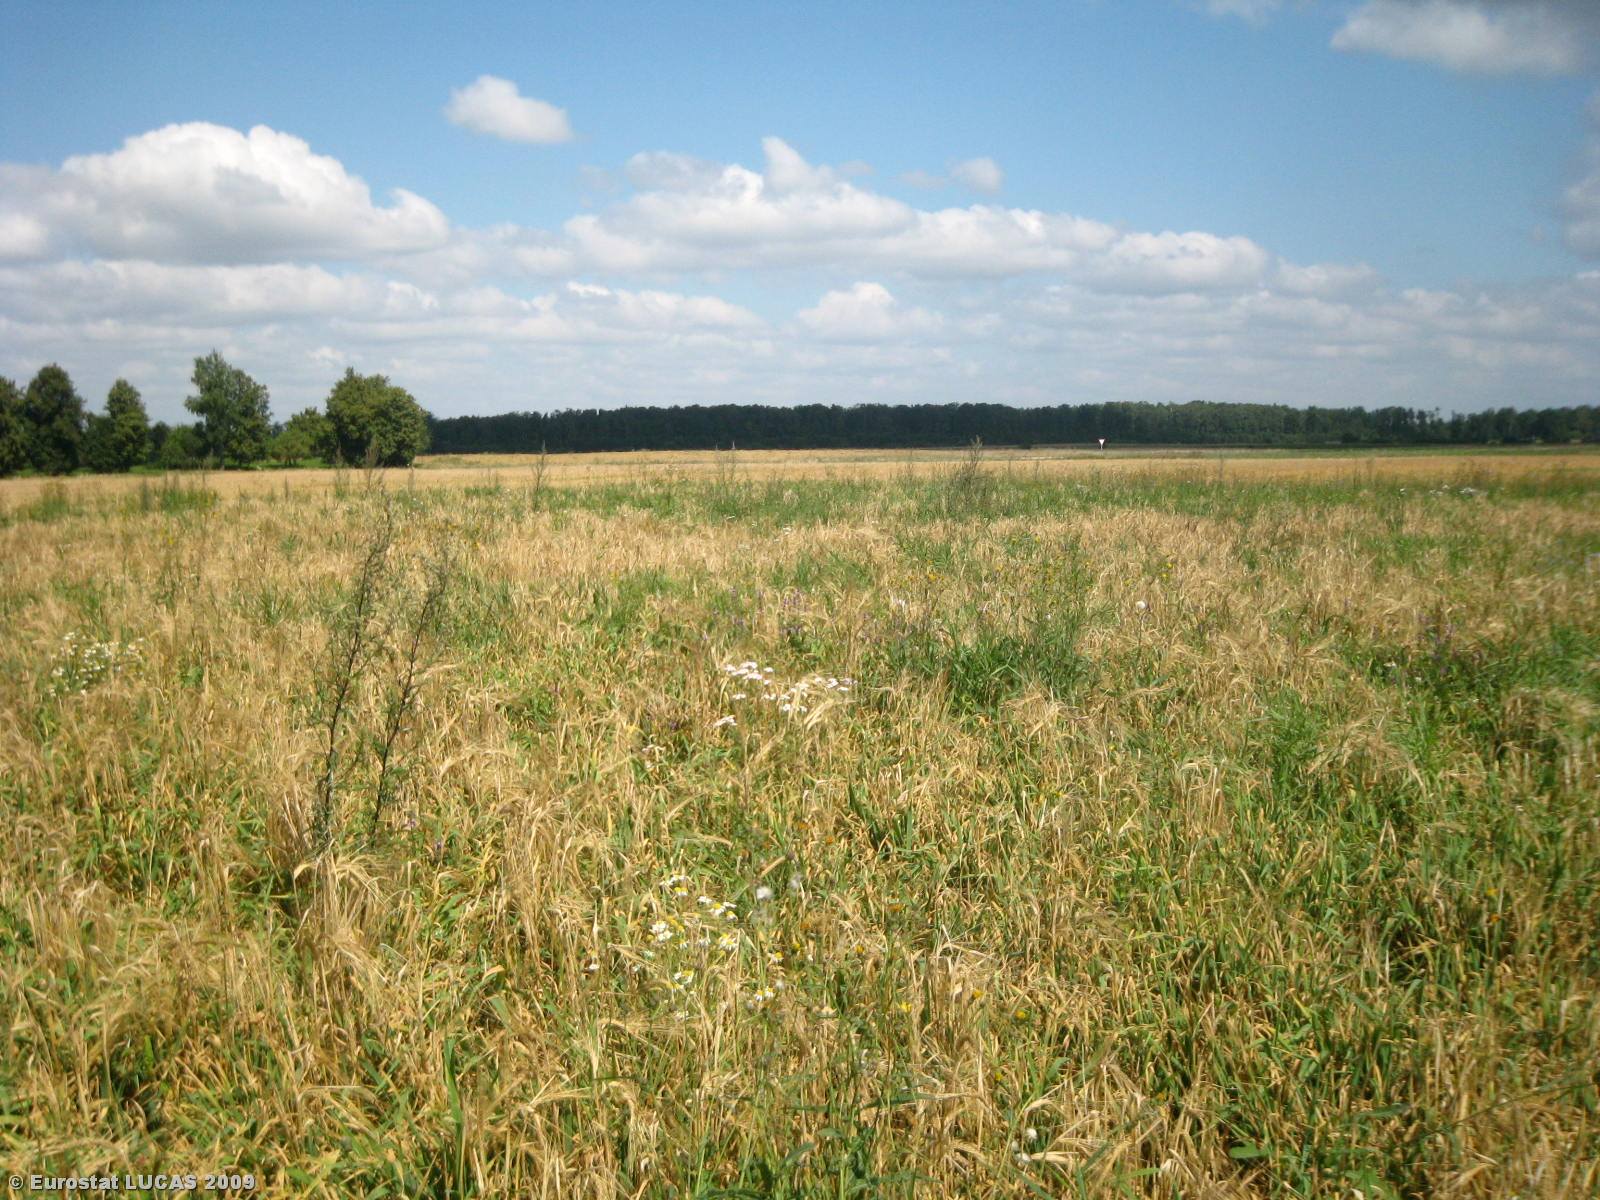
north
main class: Cropland
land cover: Barley
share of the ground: > 75 %
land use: Agriculture (excluding fallow land and kitchen gardens)
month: August
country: LT
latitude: 55.1921
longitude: 23.7031
